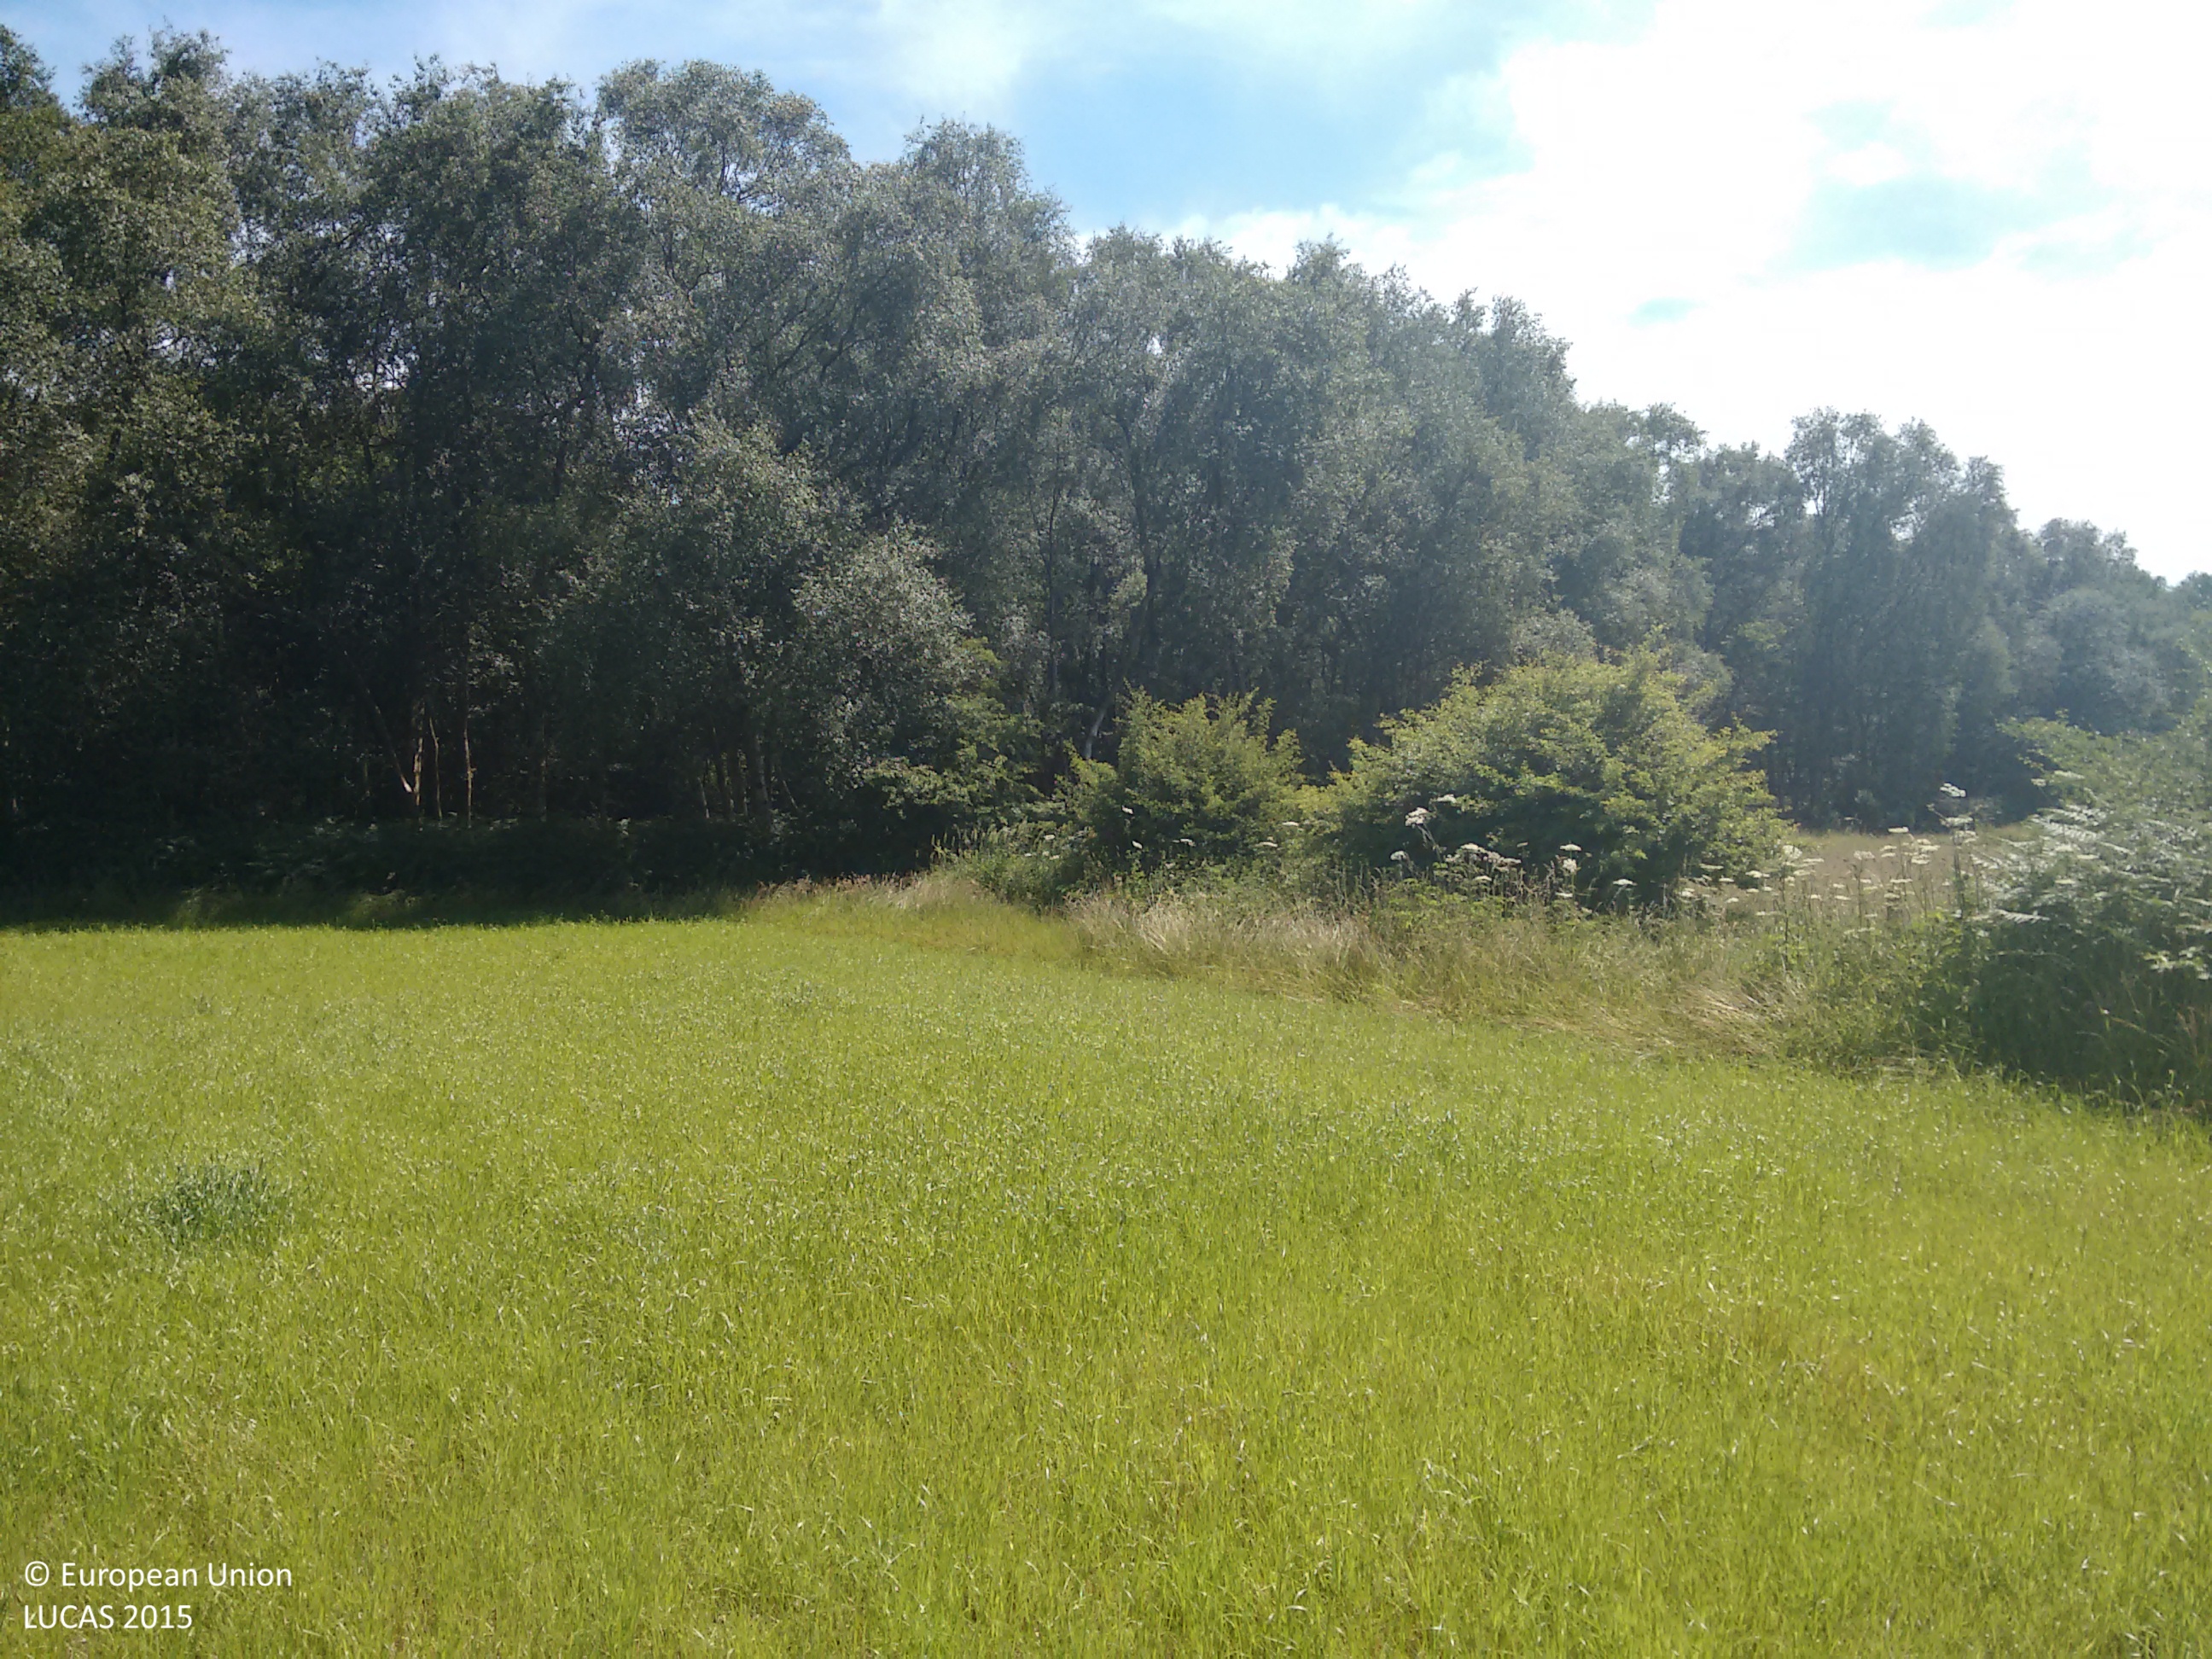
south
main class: Cropland
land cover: Temporary grasslands
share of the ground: > 75 %
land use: Agriculture (excluding fallow land and kitchen gardens)
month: July
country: GB
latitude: 53.3321
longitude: -2.5143
